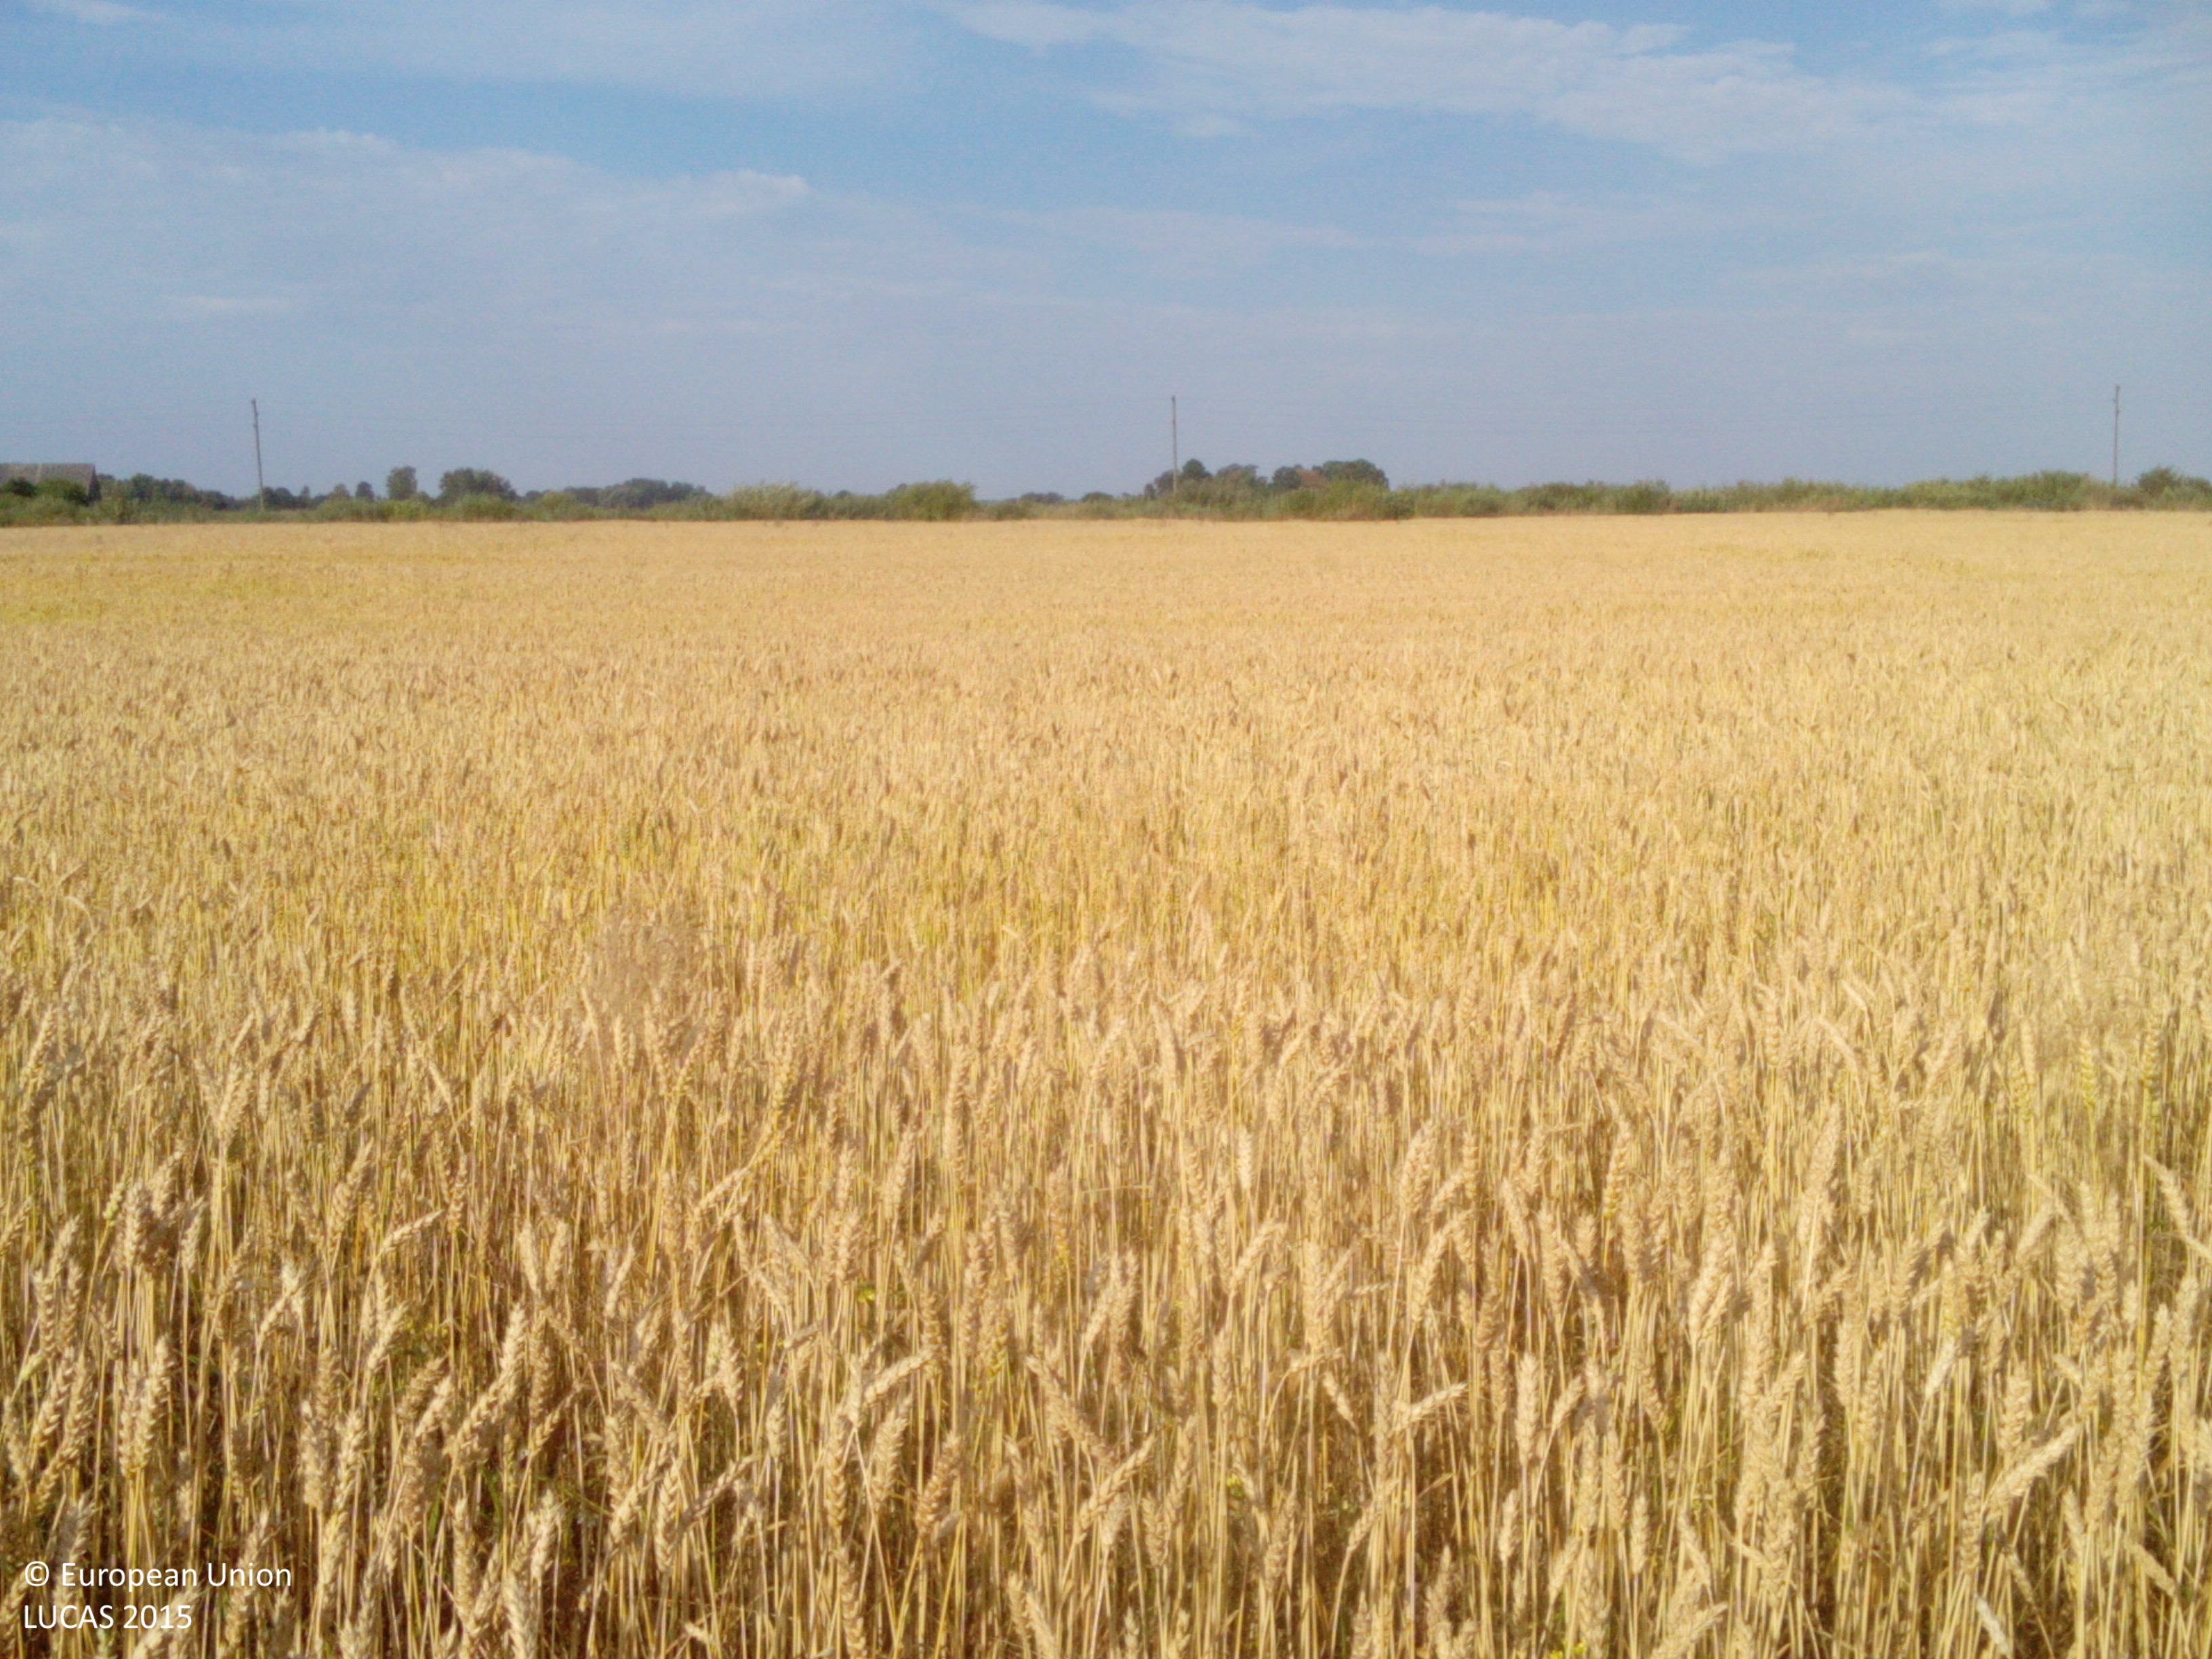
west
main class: Cropland
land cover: Common wheat
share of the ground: > 75 %
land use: Agriculture (excluding fallow land and kitchen gardens)
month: August
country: LV
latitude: 56.3798
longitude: 21.0652
